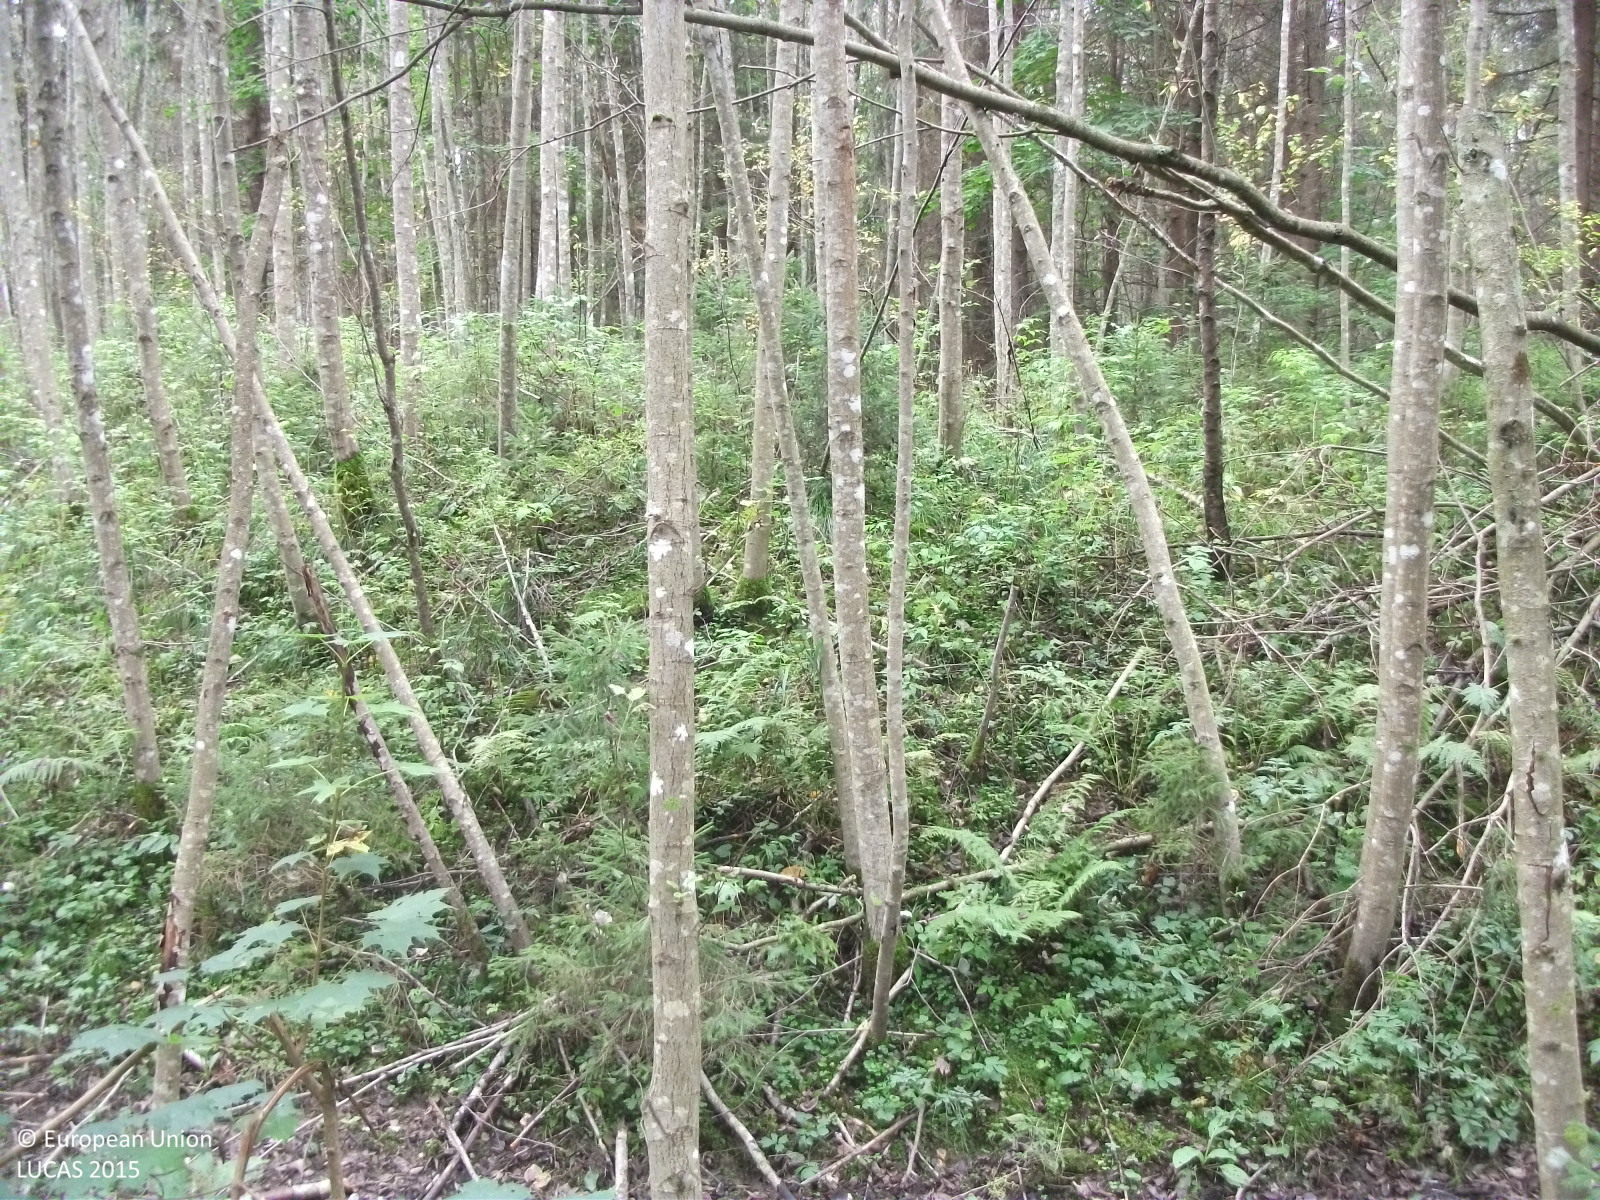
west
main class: Woodland
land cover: Spruce dominated mixed woodland
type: hemiboreal forest and nemoral coniferous forest and mixed broadleaved-coniferous forest
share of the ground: > 75 %
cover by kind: broadleaved forest trees 70 %, coniferous forest trees 25 %, herbaceous plants 5 %
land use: Forestry
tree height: > 5 m
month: September
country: LV
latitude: 57.6803
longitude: 24.5297
